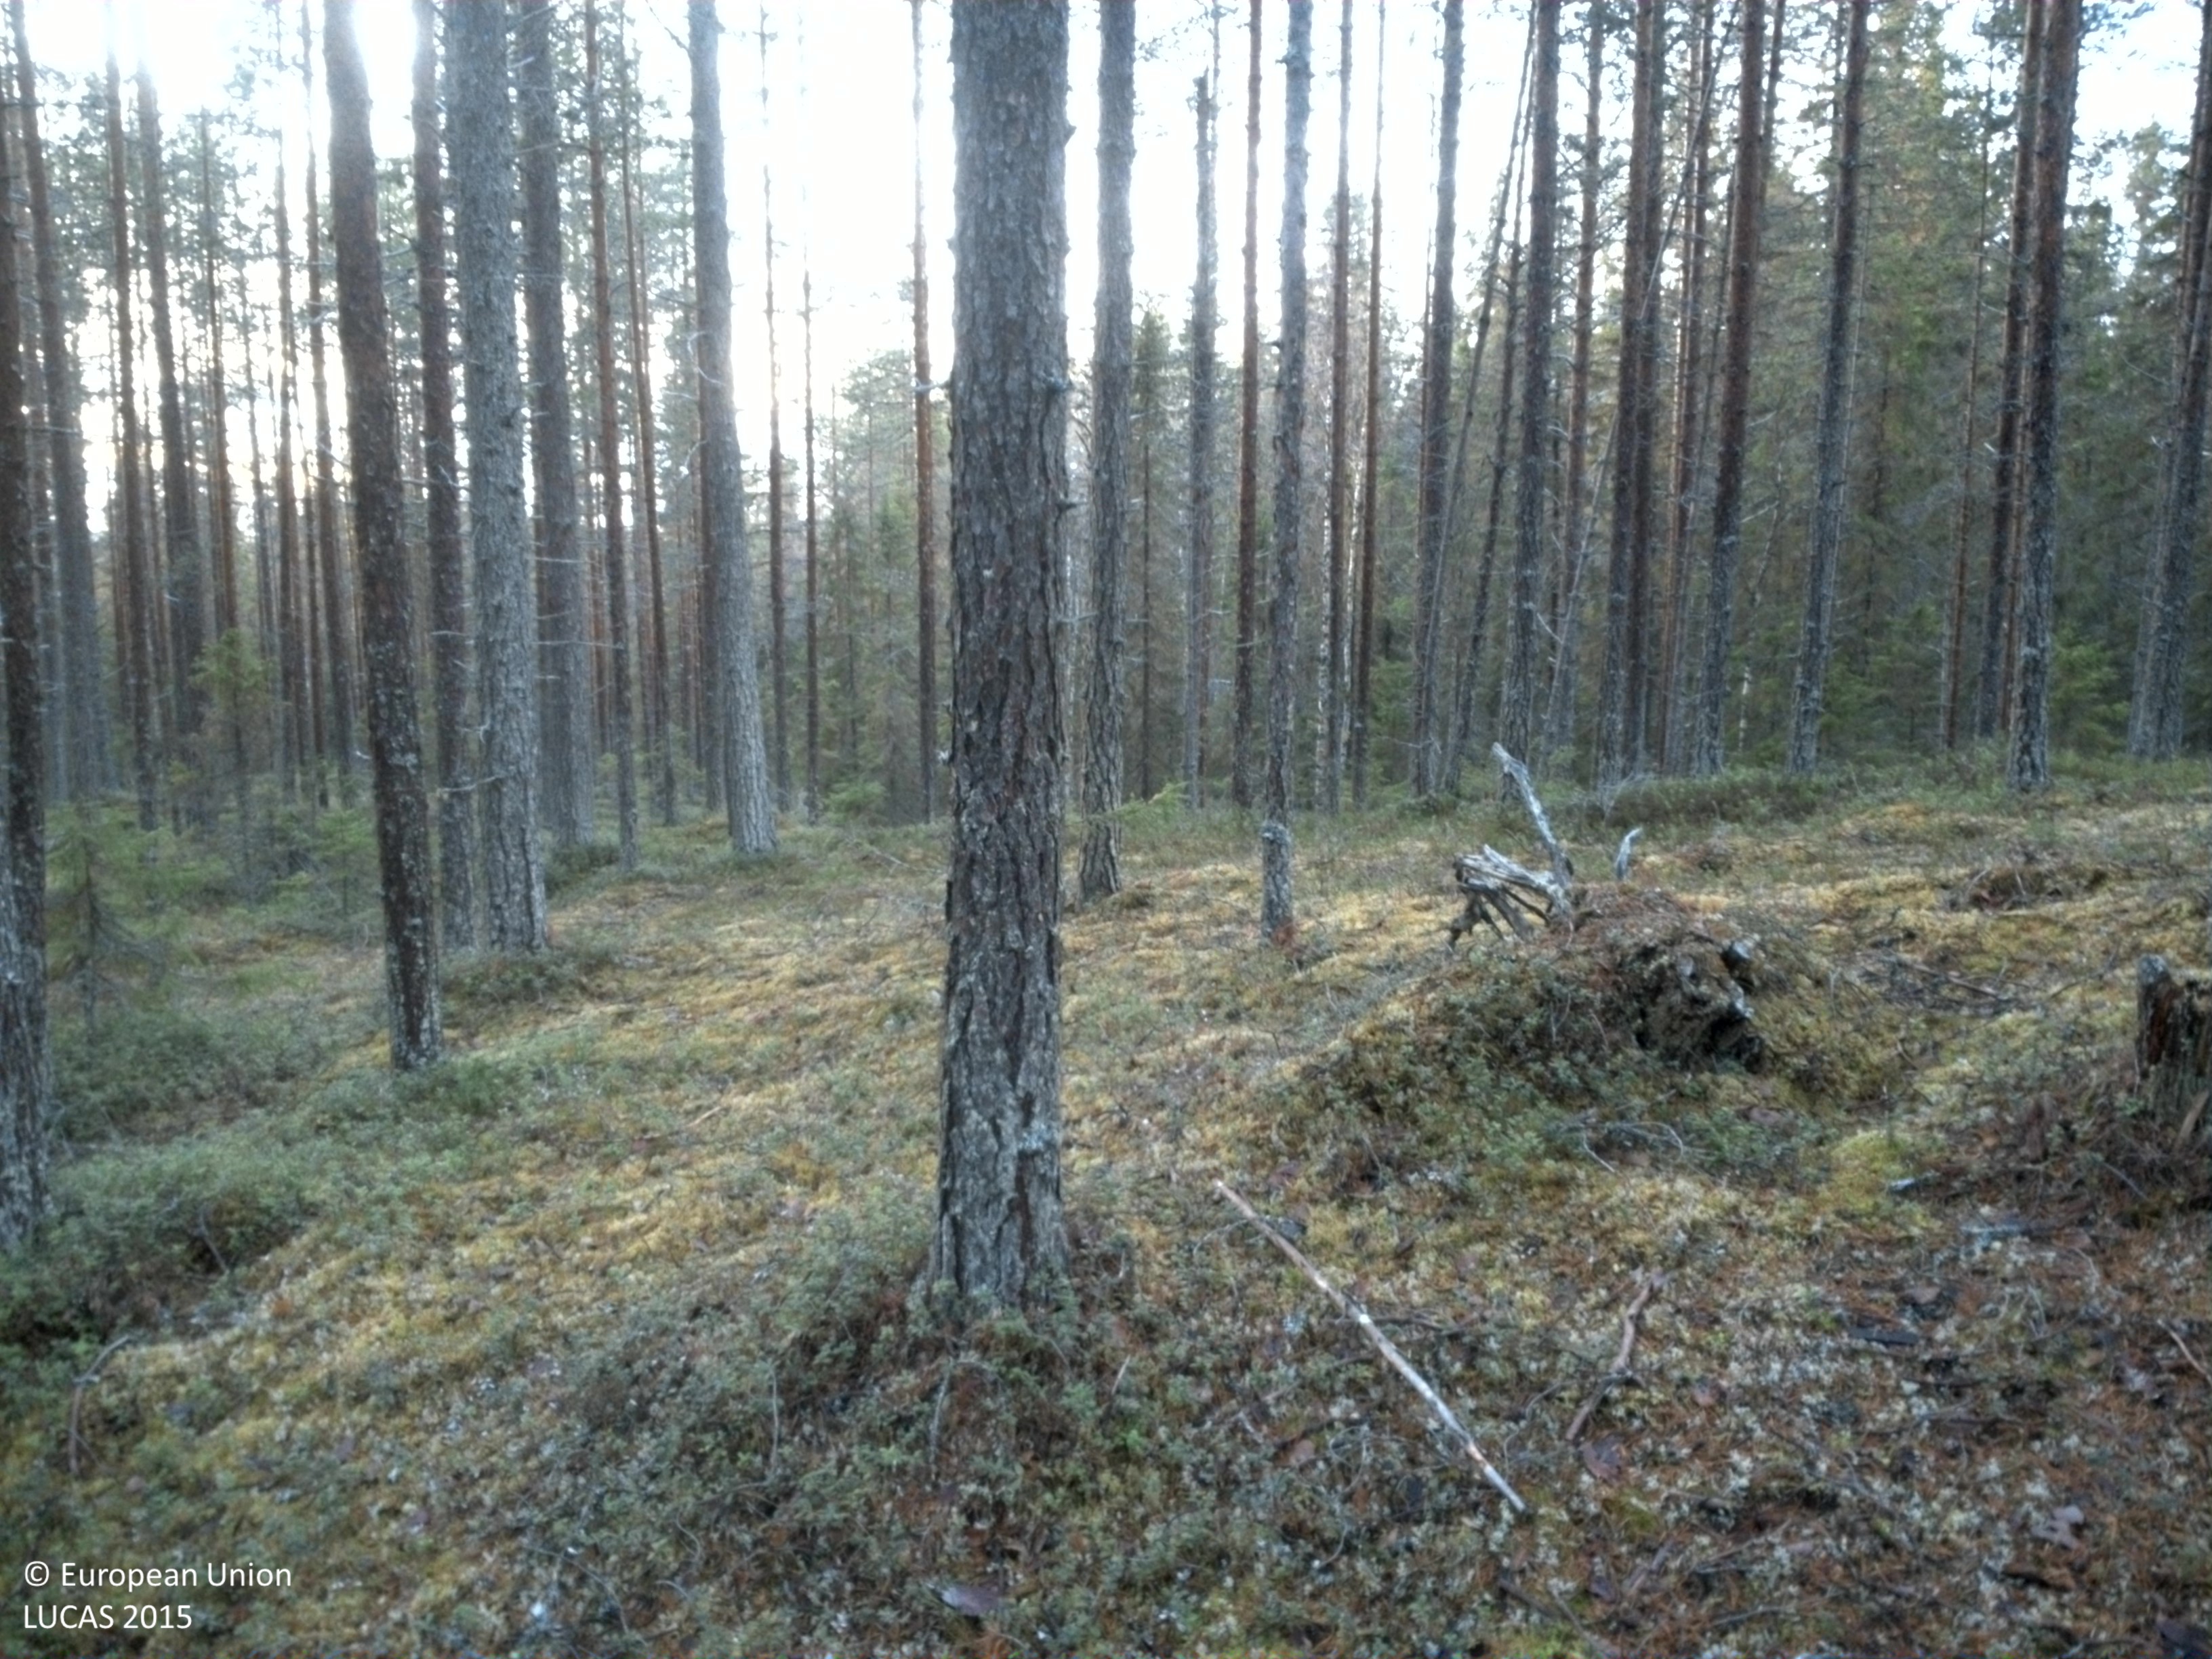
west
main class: Woodland
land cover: Pine dominated coniferous woodland
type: boreal forest
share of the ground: 25 - 50 %
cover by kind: coniferous forest trees 35 %, lichens and mosses 35 %, shrubs 30 %
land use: Forestry
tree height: > 5 m
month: October
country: SE
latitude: 64.3943
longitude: 16.8740
